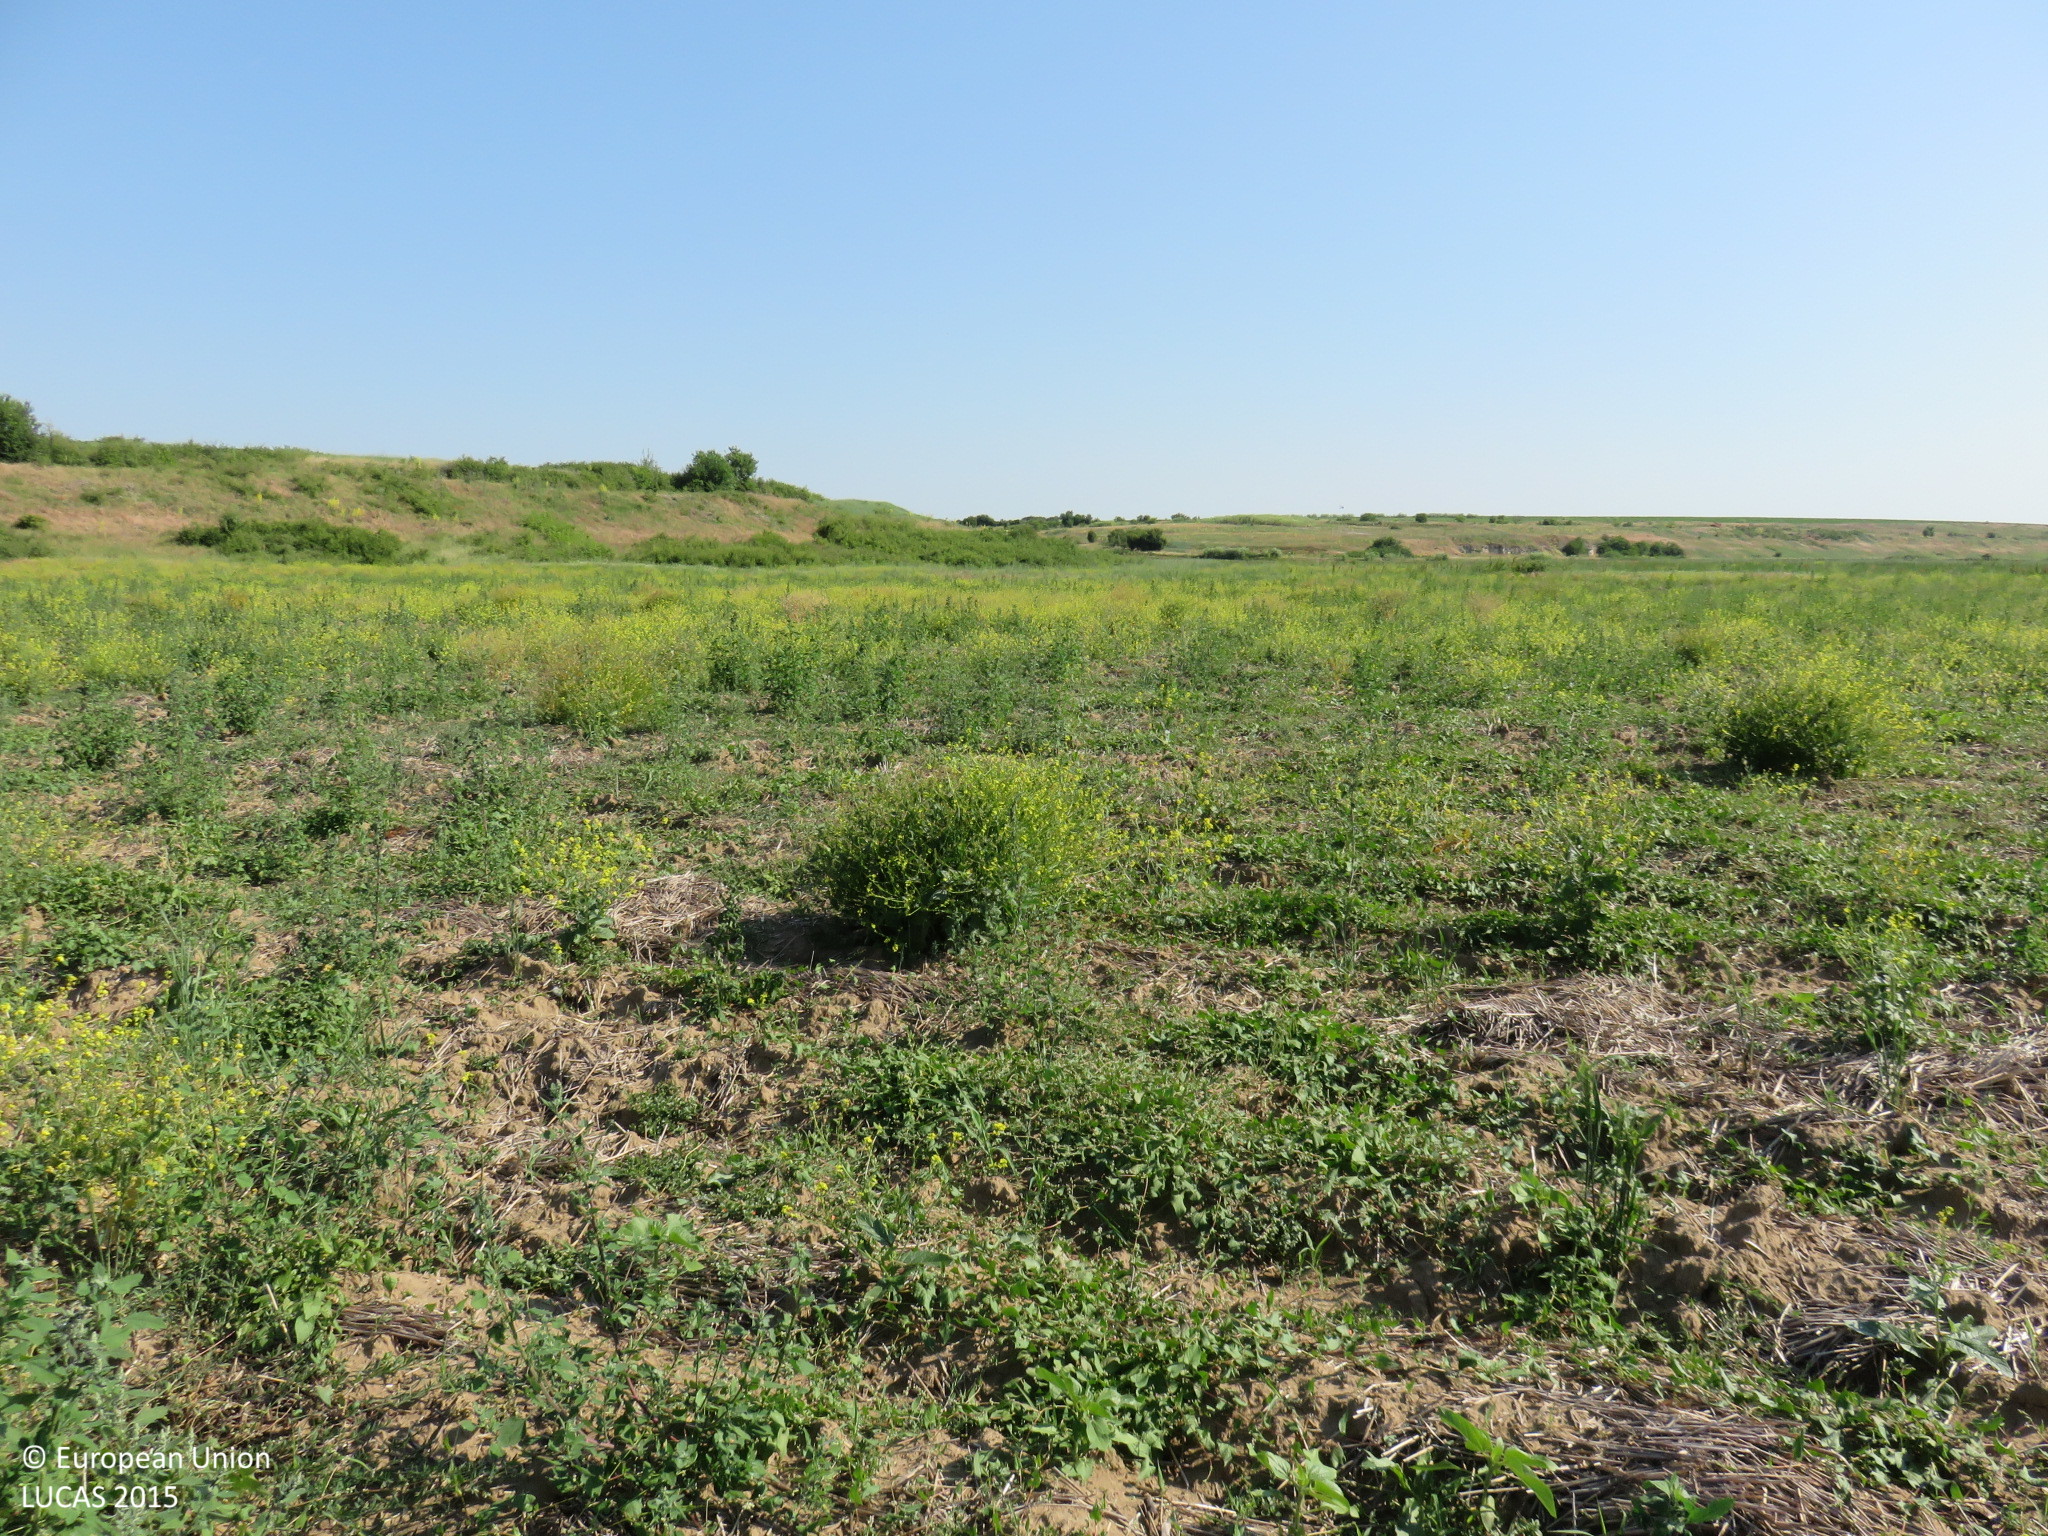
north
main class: Grassland
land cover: Spontaneously vegetated surfaces
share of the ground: > 75 %
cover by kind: herbaceous plants 90 %, consolidated bare surface 10 %
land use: Agriculture (excluding fallow land and kitchen gardens)
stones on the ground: < 10 %
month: June
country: BG
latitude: 43.3218
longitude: 24.3993
